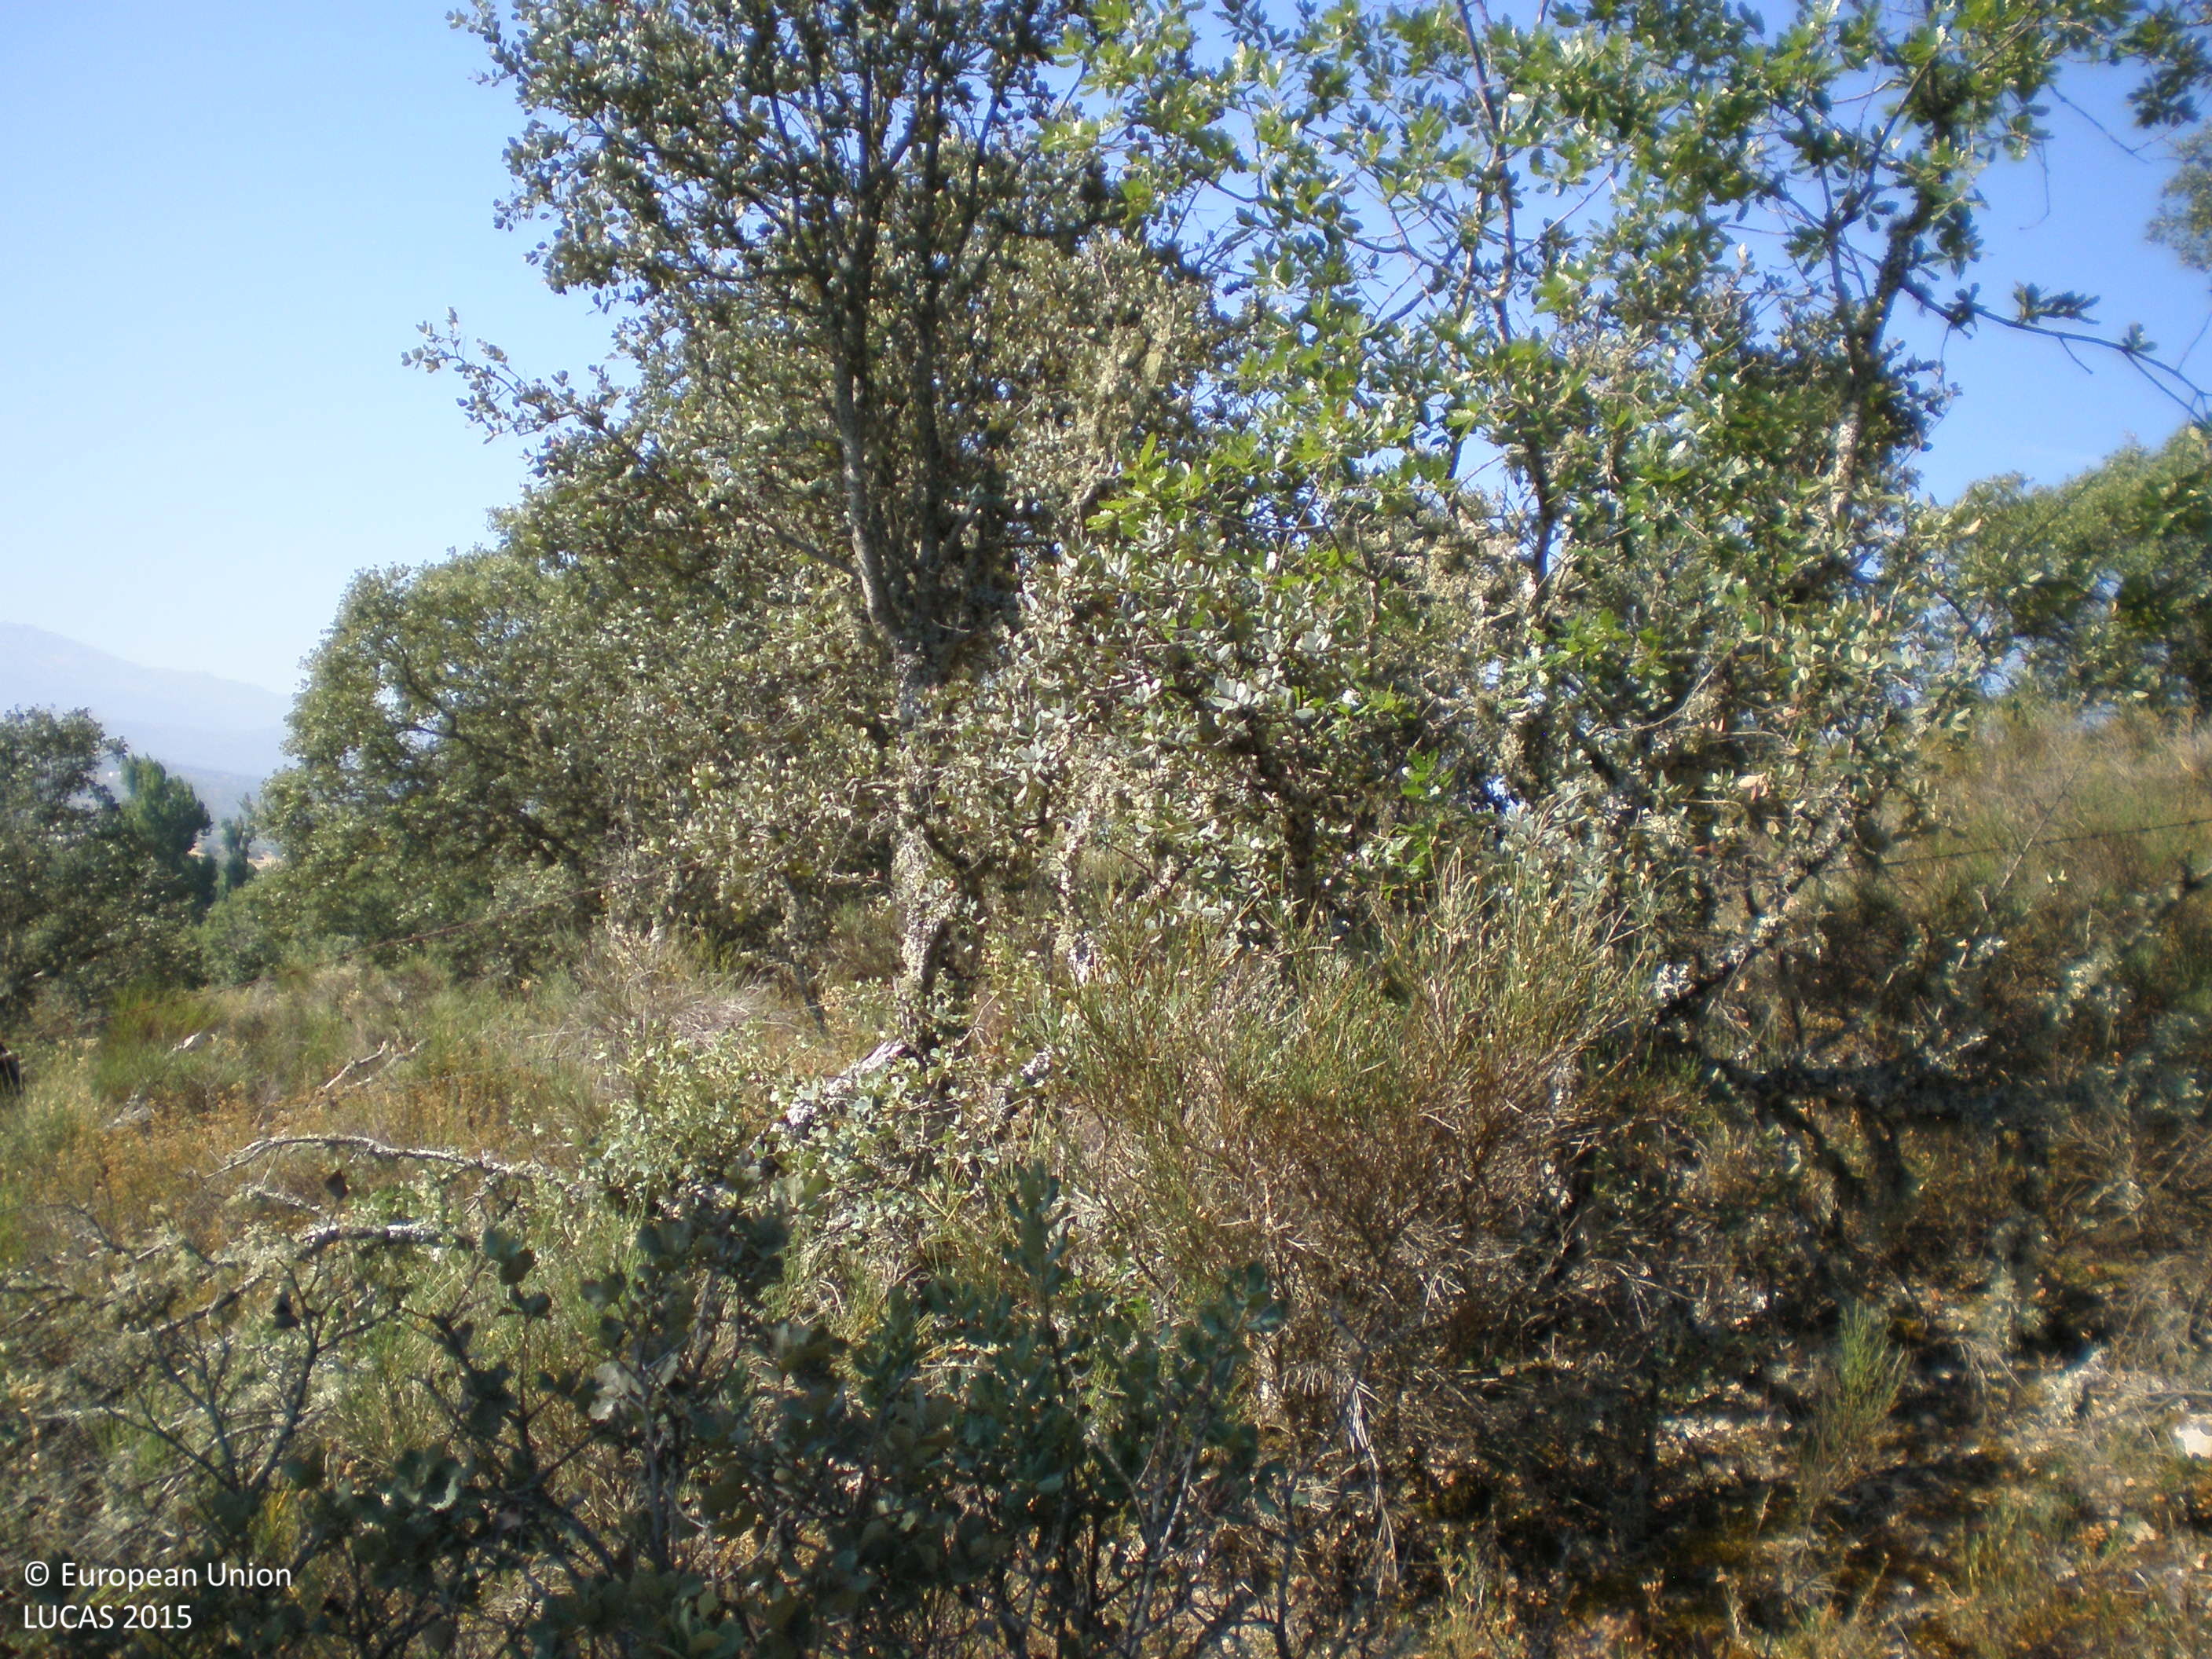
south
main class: Woodland
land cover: Broadleaved woodland
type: broadleaved evergreen forest
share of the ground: 50 - 75 %
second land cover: Grassland without tree/shrub cover
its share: 25 - 50 %
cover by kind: broadleaved forest trees 55 %, herbaceous plants 45 %
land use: Forestry
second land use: Agriculture (excluding fallow land and kitchen gardens)
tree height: > 5 m
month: July
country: ES
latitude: 40.4685
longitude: -5.7942
